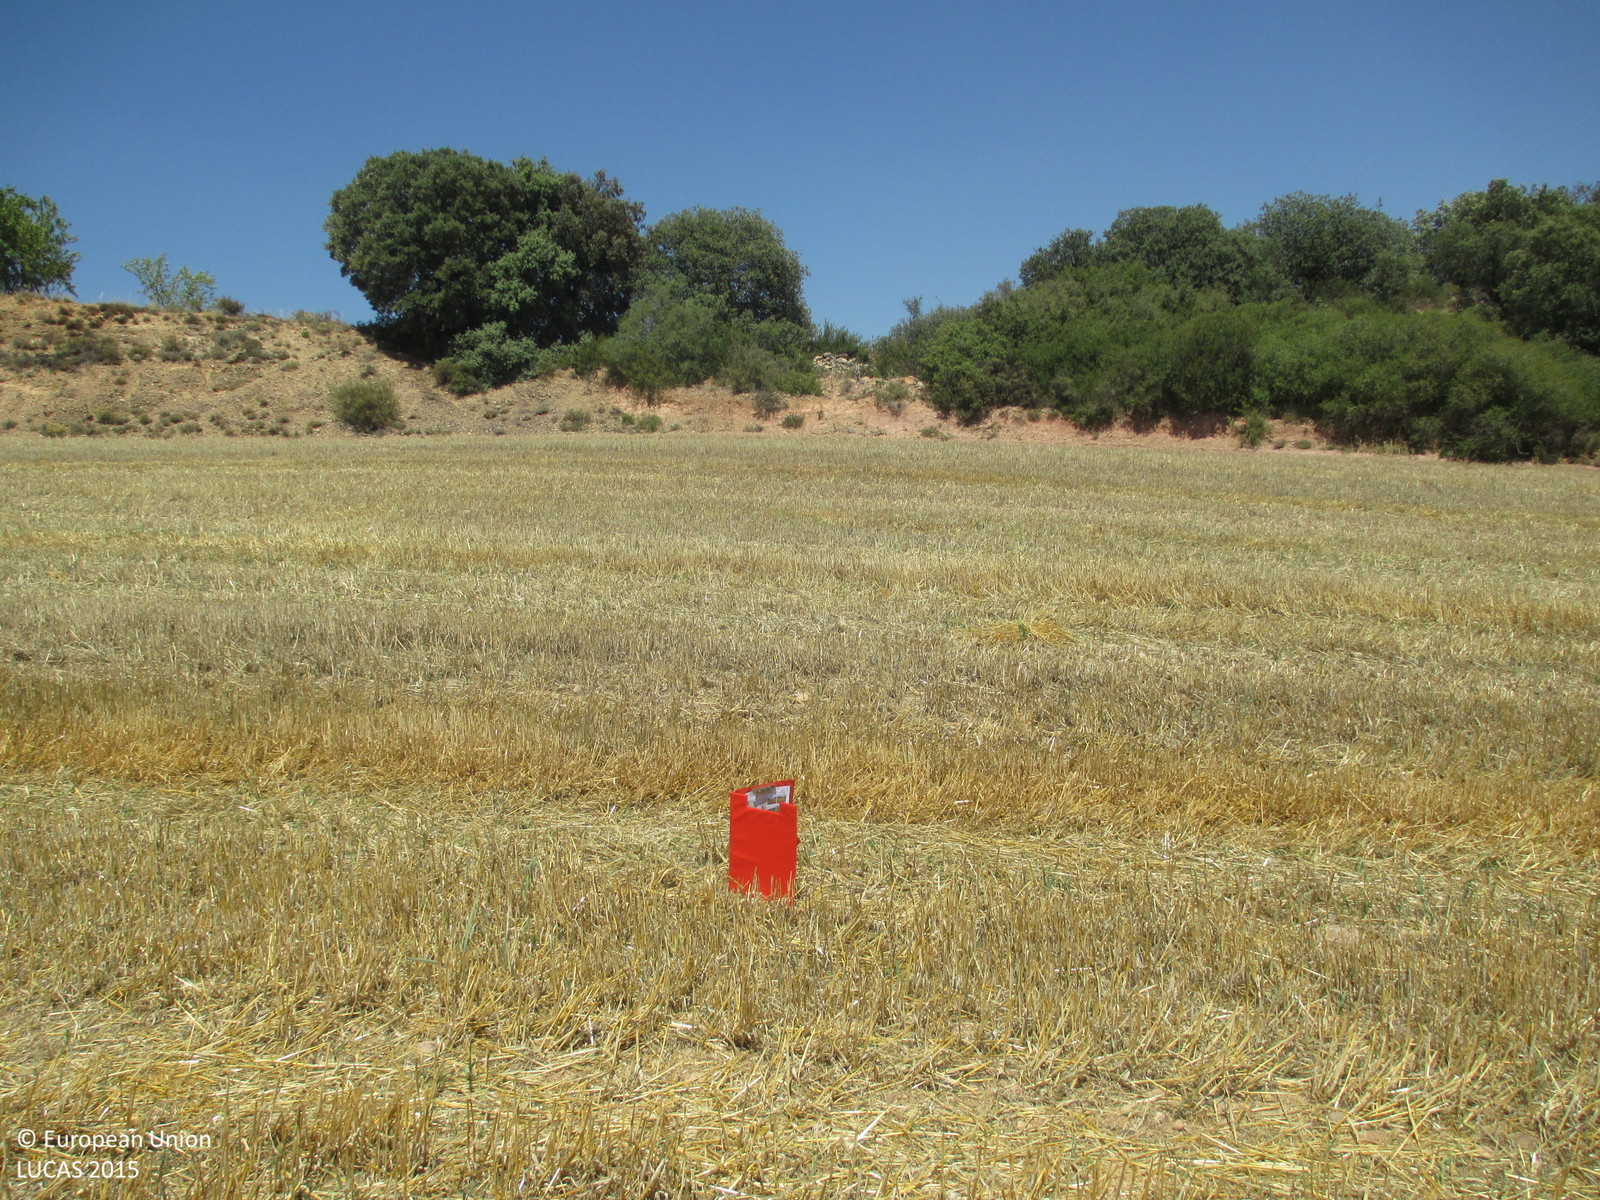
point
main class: Cropland
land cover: Barley
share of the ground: < 10 %
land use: Agriculture (excluding fallow land and kitchen gardens)
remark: Harvested field
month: June
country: ES
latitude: 42.0835
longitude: -0.0168
